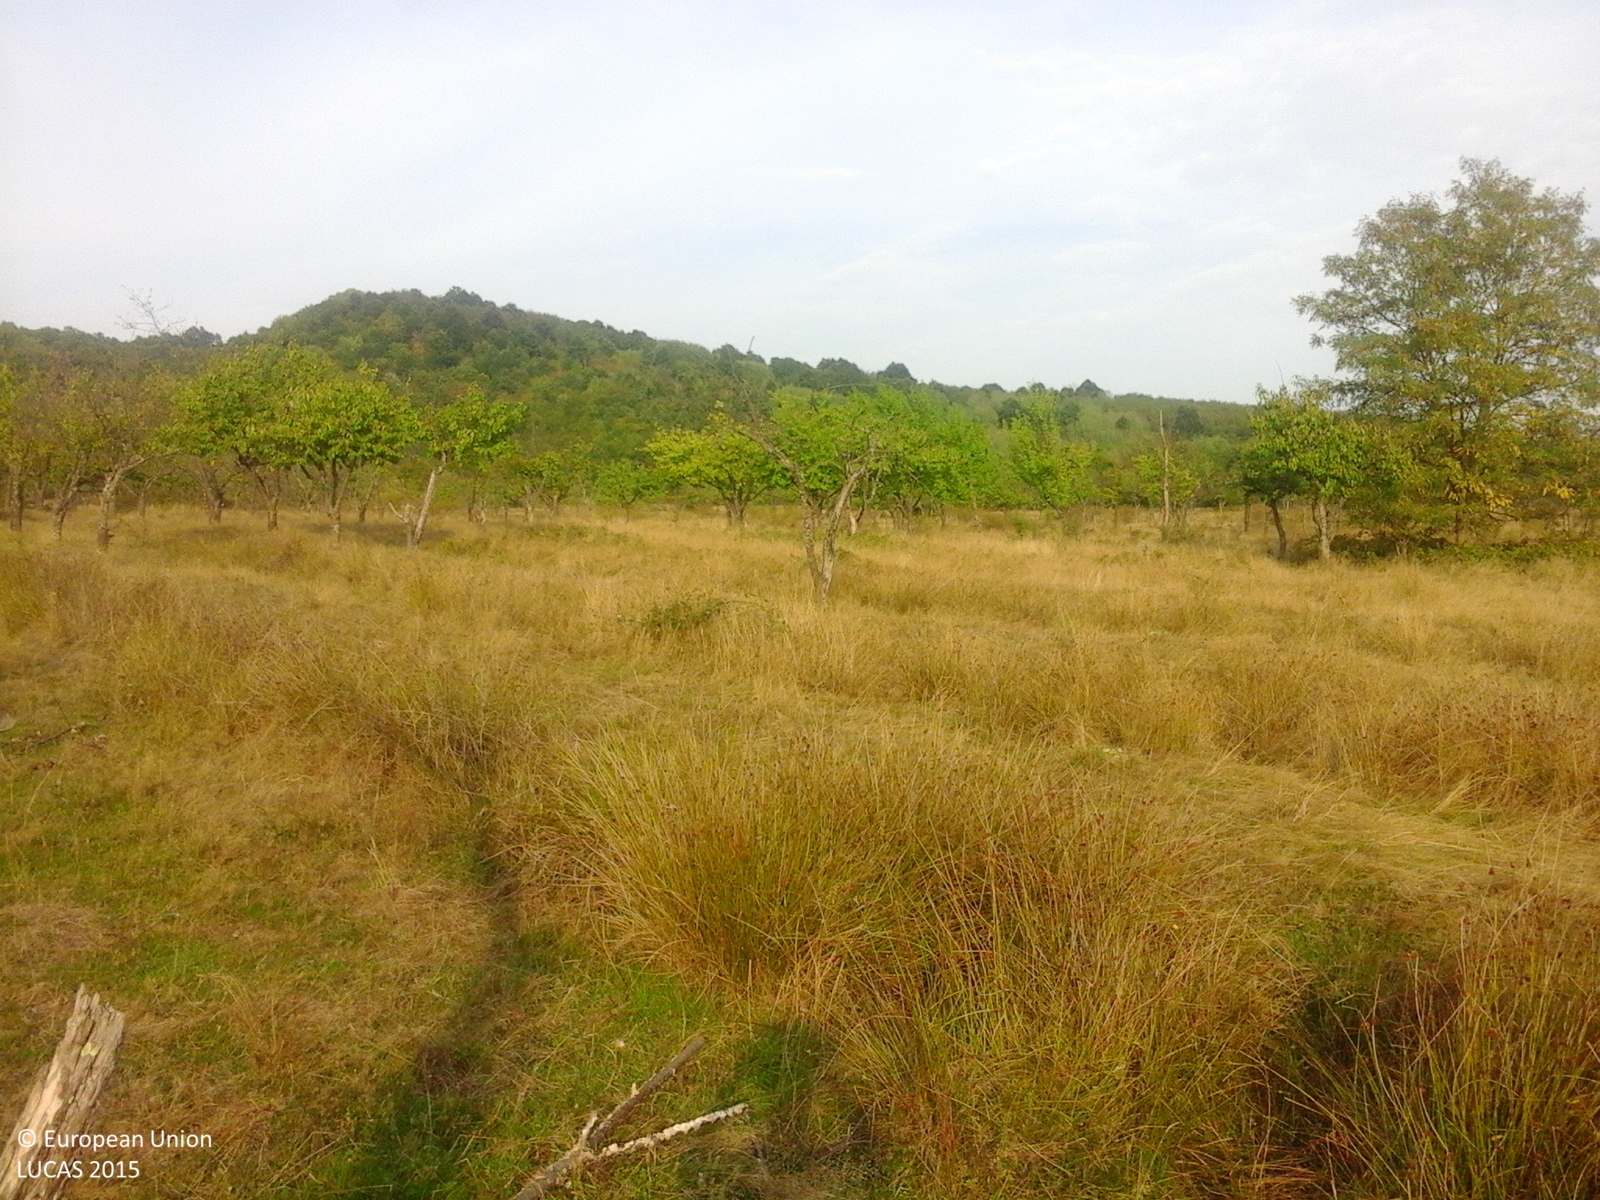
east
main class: Cropland
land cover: Cherry fruit
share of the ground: 50 - 75 %
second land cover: Grassland without tree/shrub cover
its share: > 75 %
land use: Agriculture (excluding fallow land and kitchen gardens)
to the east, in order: Cherry fruit; Grassland without tree/shrub cover; Broadleaved woodland
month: September
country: RO
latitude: 45.5205
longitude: 22.2165
